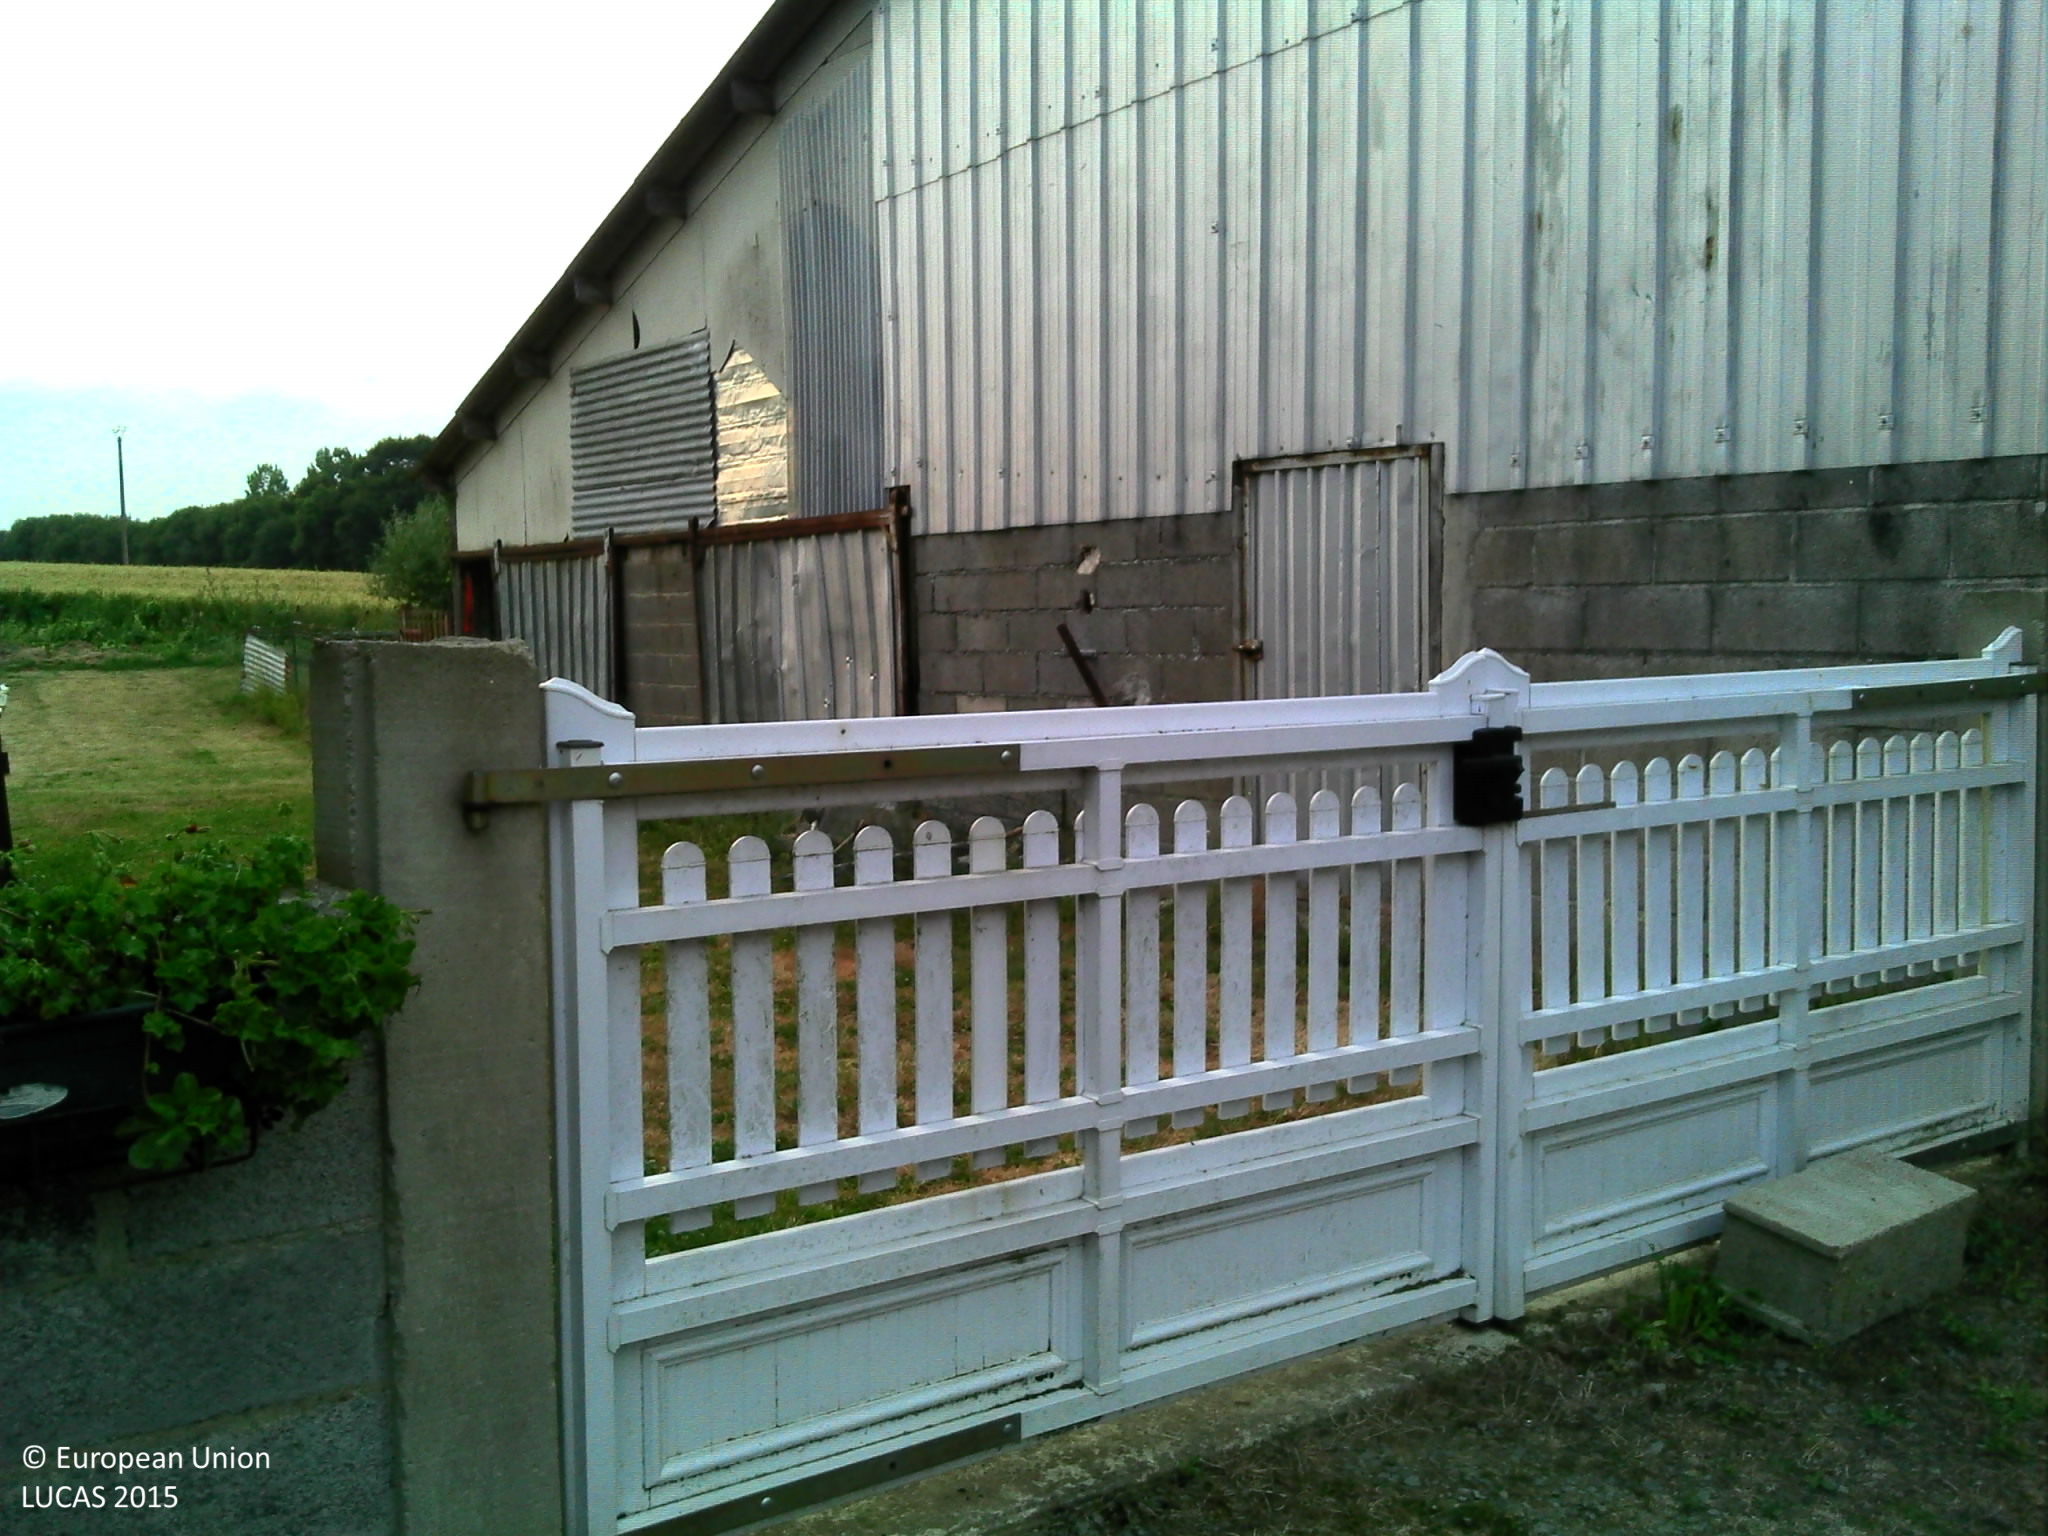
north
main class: Grassland
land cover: Grassland without tree/shrub cover
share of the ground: > 75 %
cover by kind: herbaceous plants 85 %, unconsolidated bare surface 15 %
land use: Residential
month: July
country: FR
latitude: 48.5459
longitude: -2.1805
